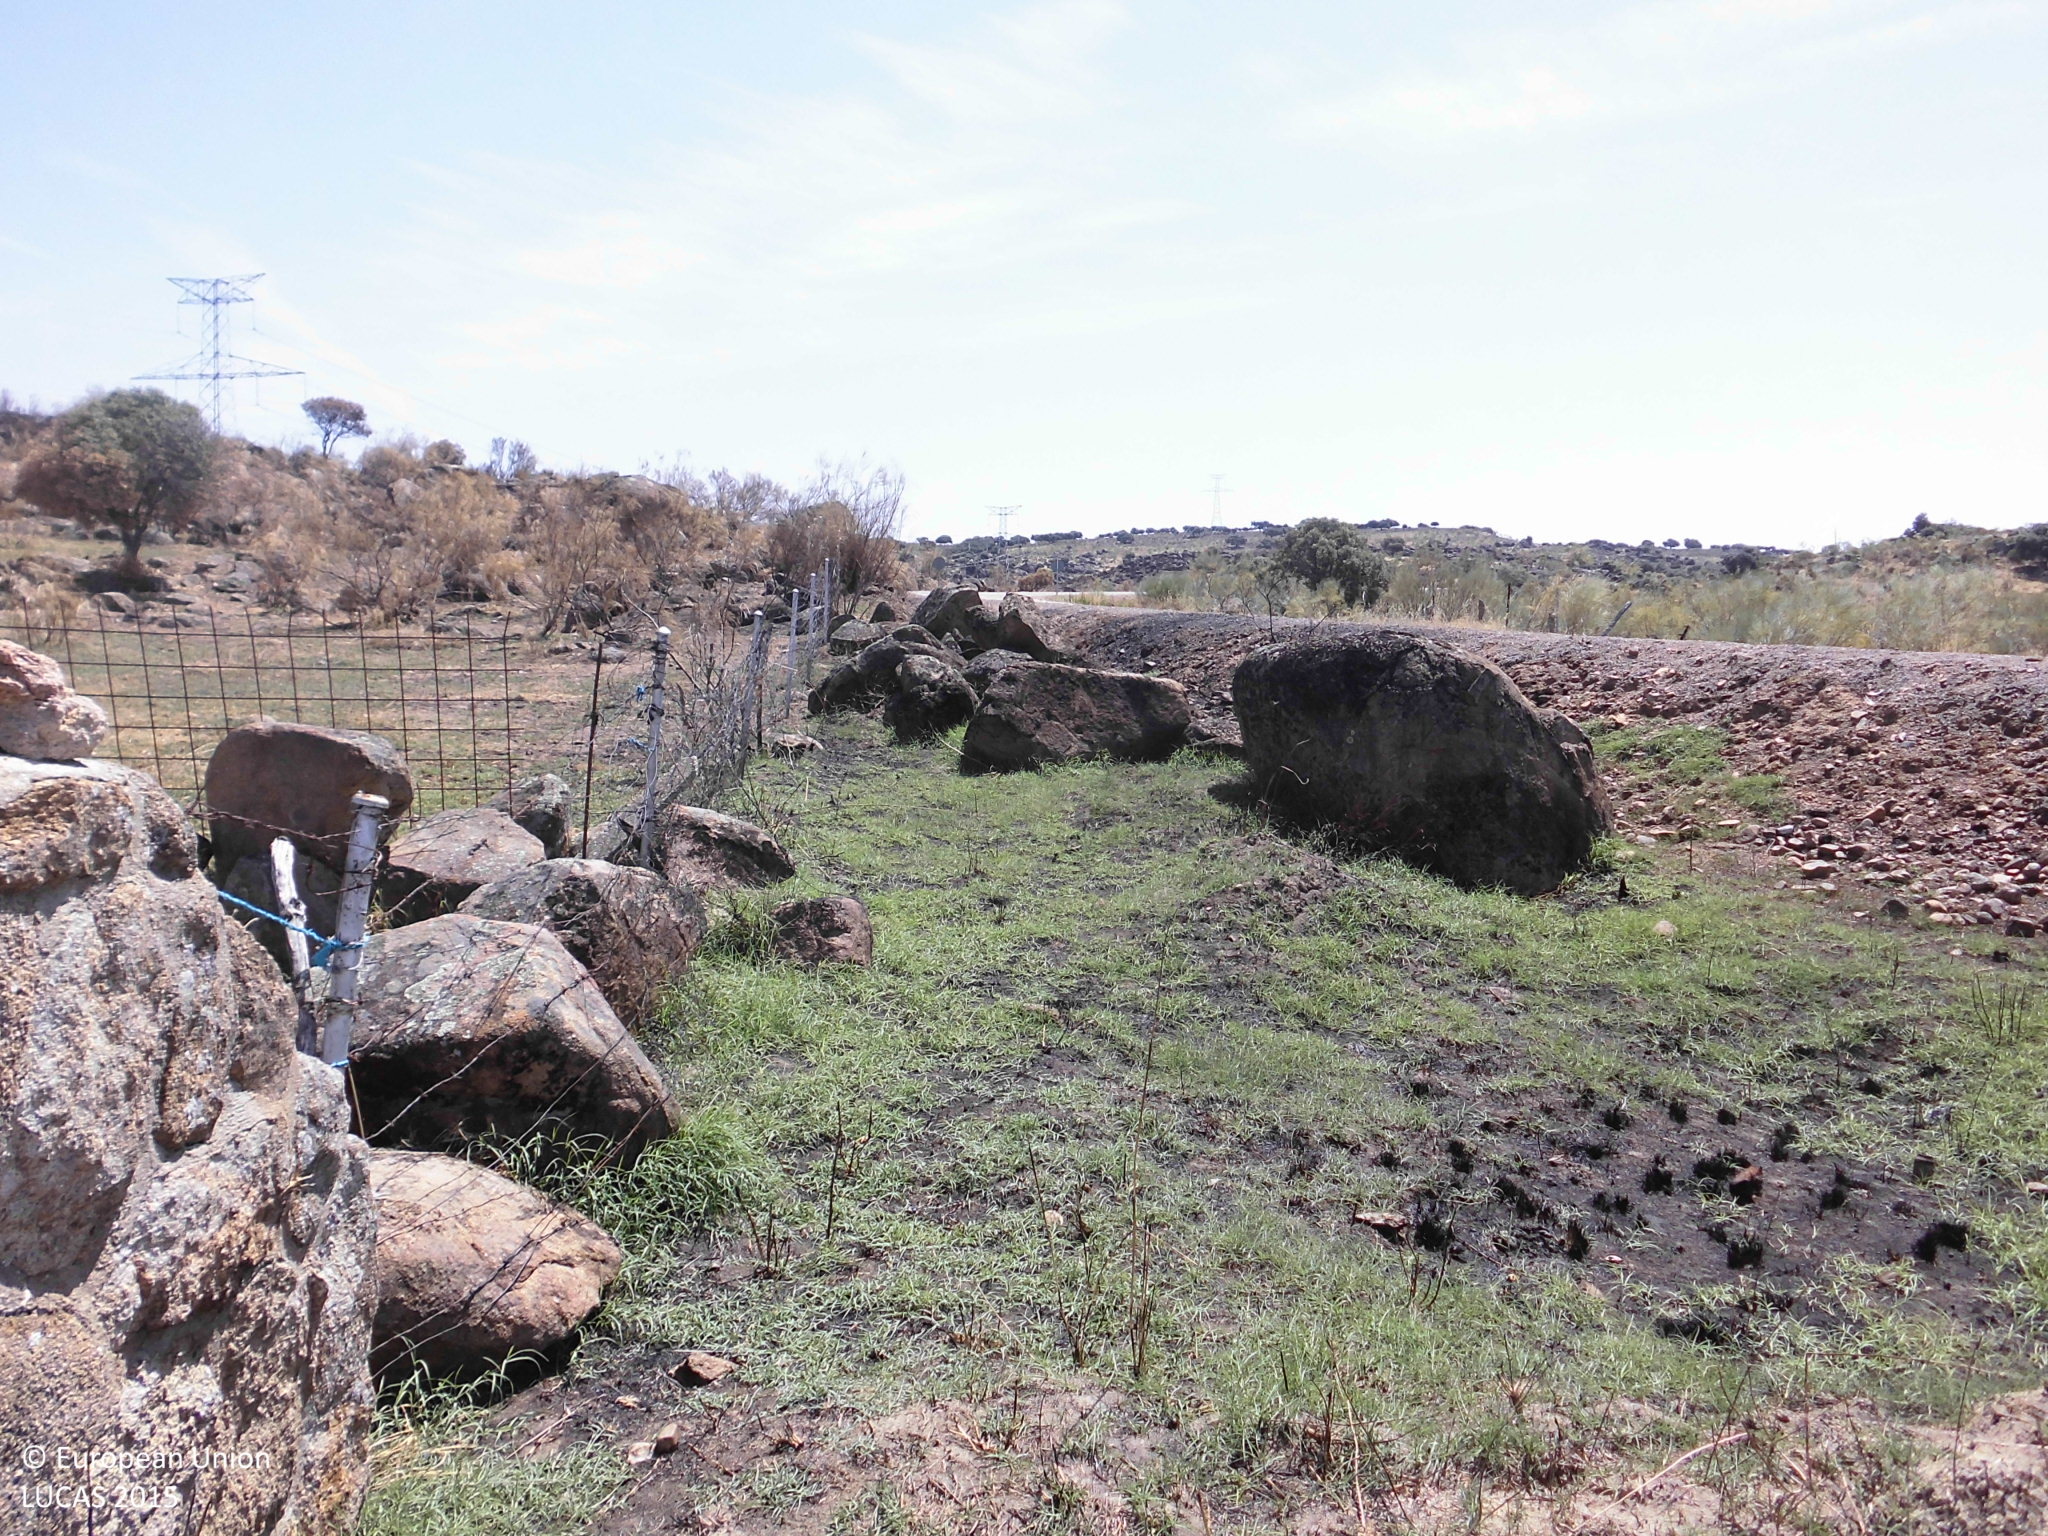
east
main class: Woodland
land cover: Broadleaved woodland
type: broadleaved evergreen forest
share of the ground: 10 - 25 %
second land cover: Grassland without tree/shrub cover
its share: > 75 %
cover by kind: herbaceous plants 80 %, broadleaved forest trees 10 %, shrubs 10 %
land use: Forestry
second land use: Agriculture (excluding fallow land and kitchen gardens)
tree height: > 5 m
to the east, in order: Broadleaved woodland; Grassland without tree/shrub cover; Shrubland without tree cover; Tracks; Shrubland without tree cover
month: July
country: ES
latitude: 39.7772
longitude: -5.4079
